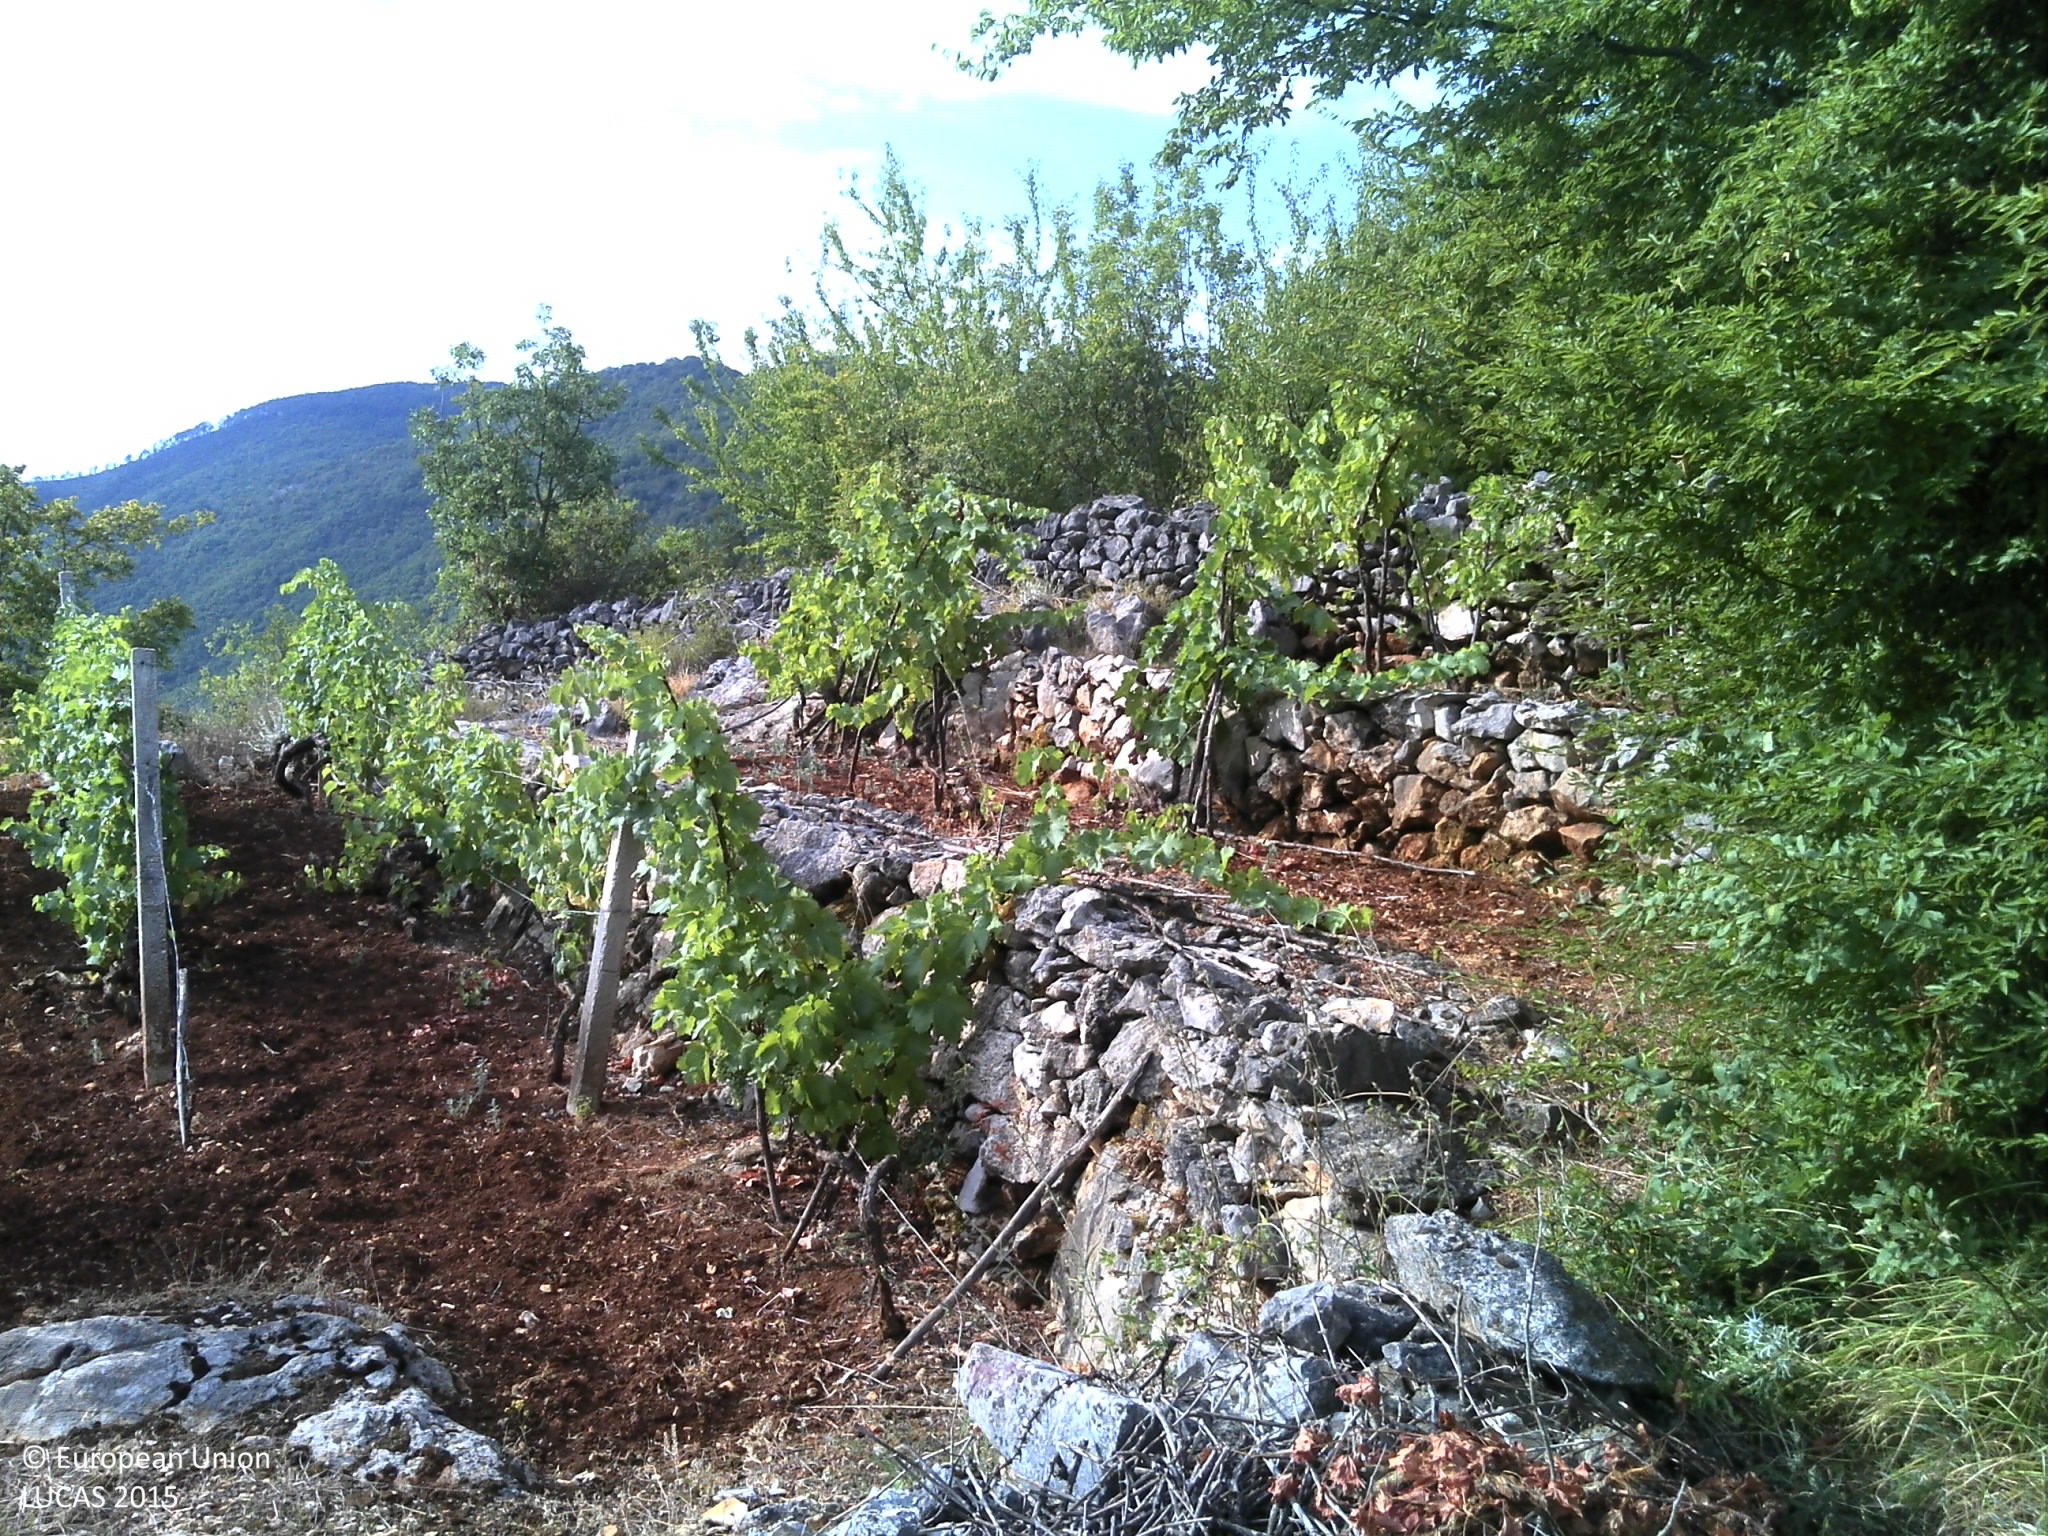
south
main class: Shrubland
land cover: Shrubland with sparse tree cover
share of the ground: > 75 %
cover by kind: shrubs 65 %, herbaceous plants 20 %, broadleaved forest trees 5 %, lichens and mosses 5 %, consolidated bare surface 5 %
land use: Semi-natural and natural areas not in use
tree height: < 5 m
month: July
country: HR
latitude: 43.4556
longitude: 17.0978
